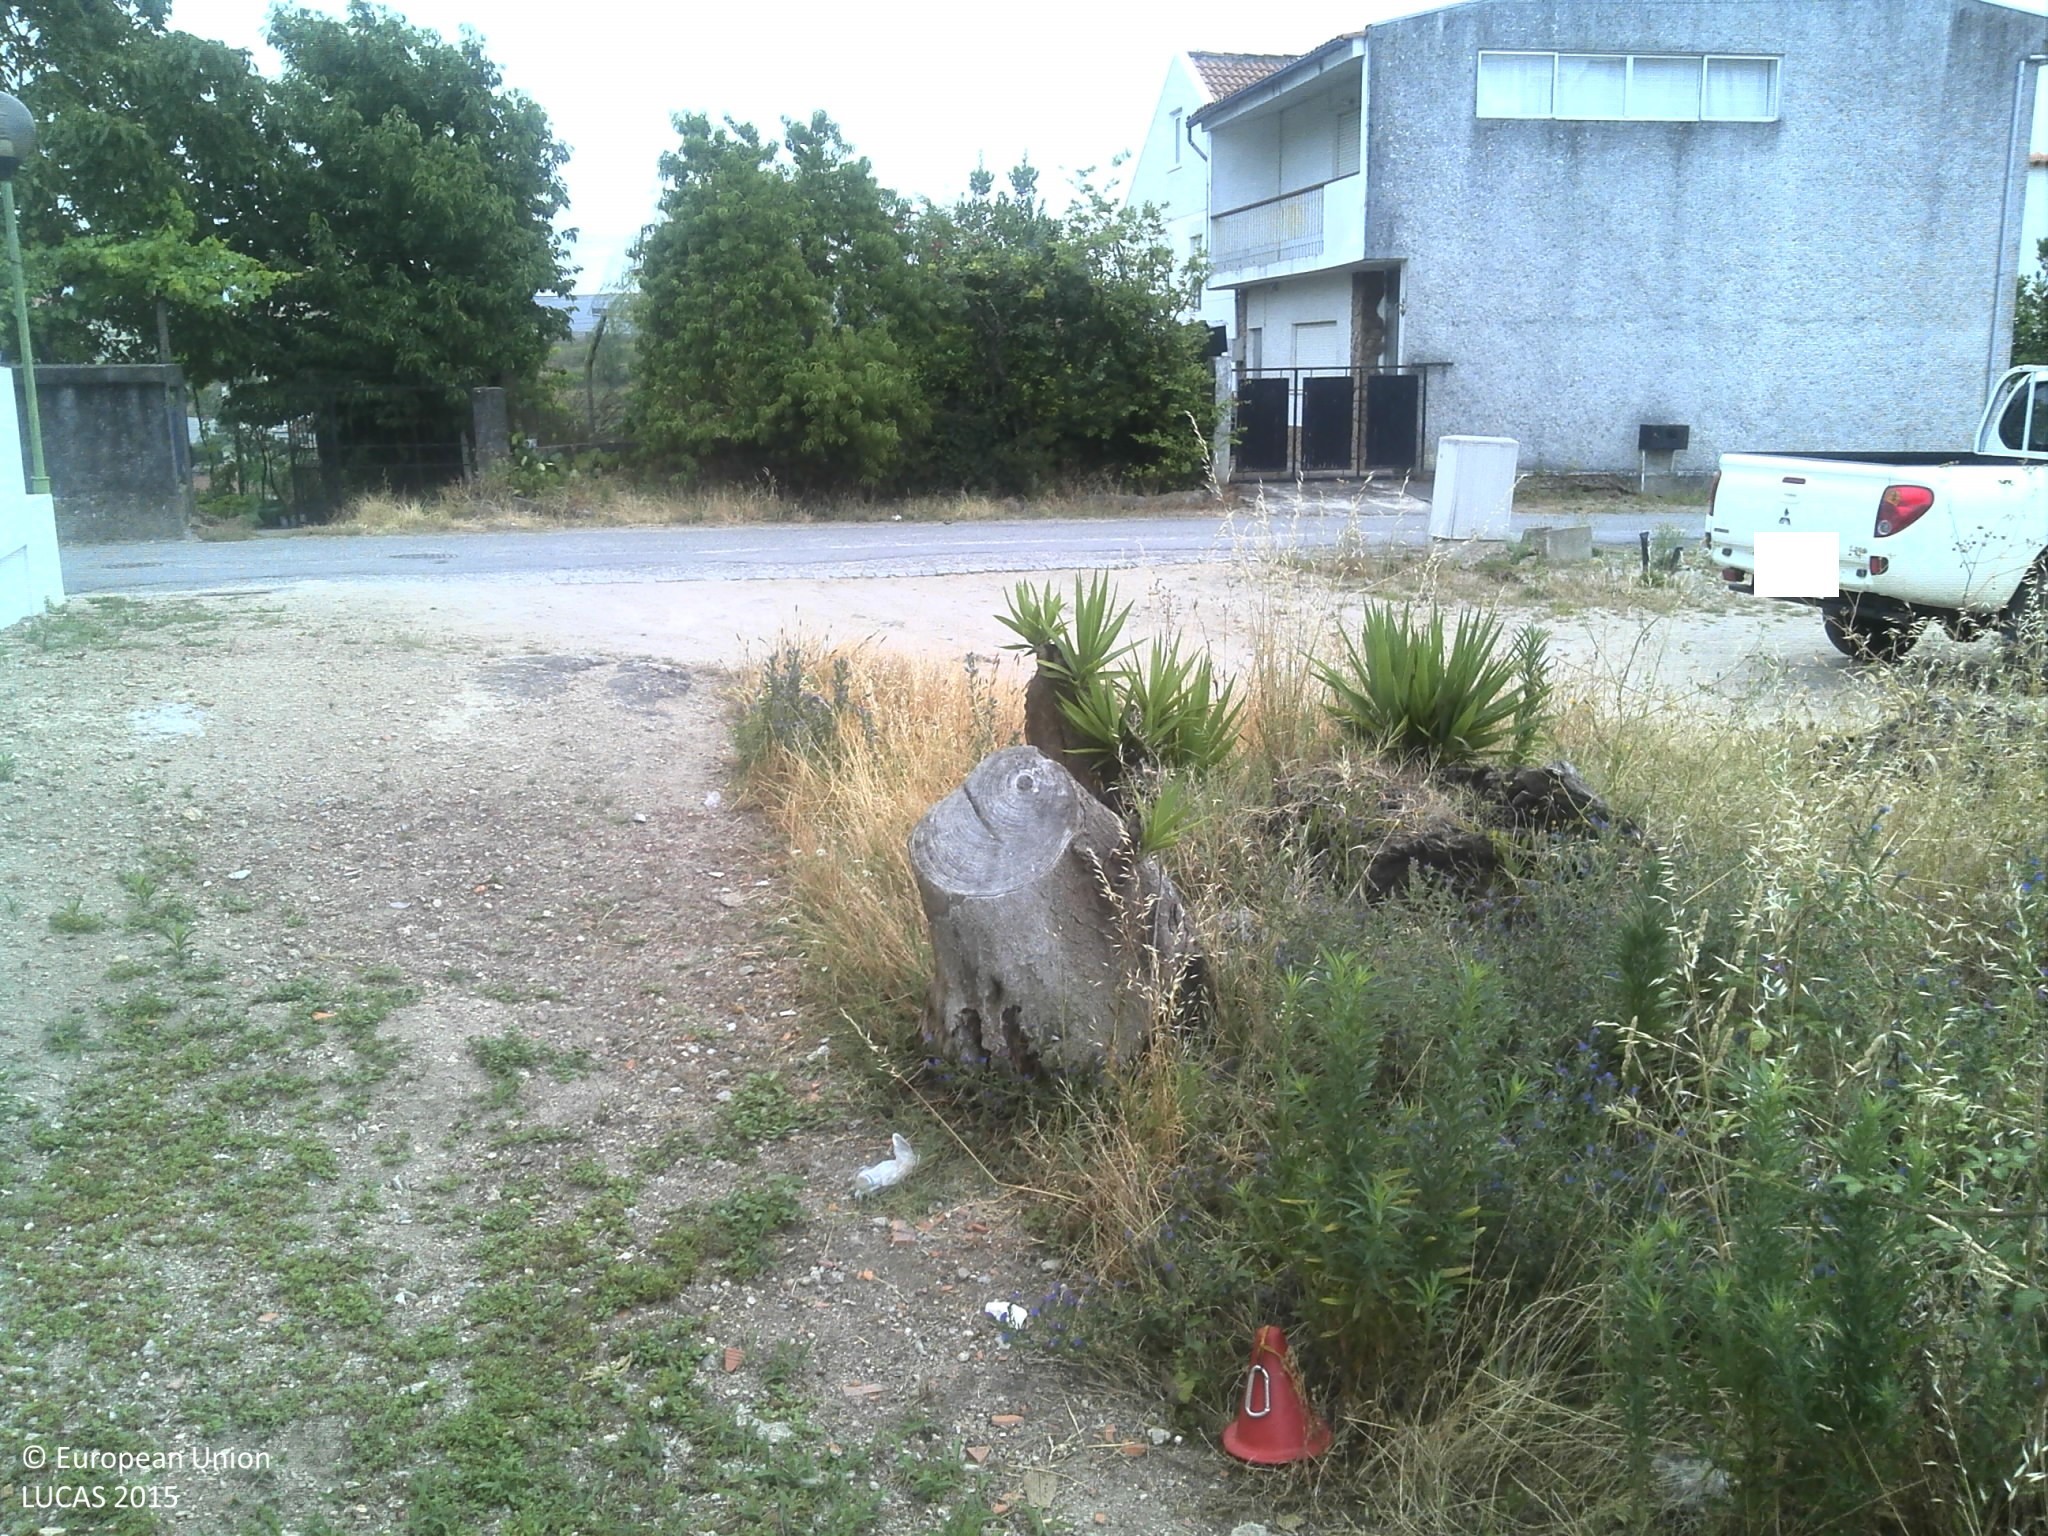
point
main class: Shrubland
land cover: Shrubland without tree cover
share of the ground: 50 - 75 %
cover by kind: herbaceous plants 60 %, unconsolidated bare surface 25 %, shrubs 15 %
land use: Residential
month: June
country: PT
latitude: 41.1820
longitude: -8.1530
